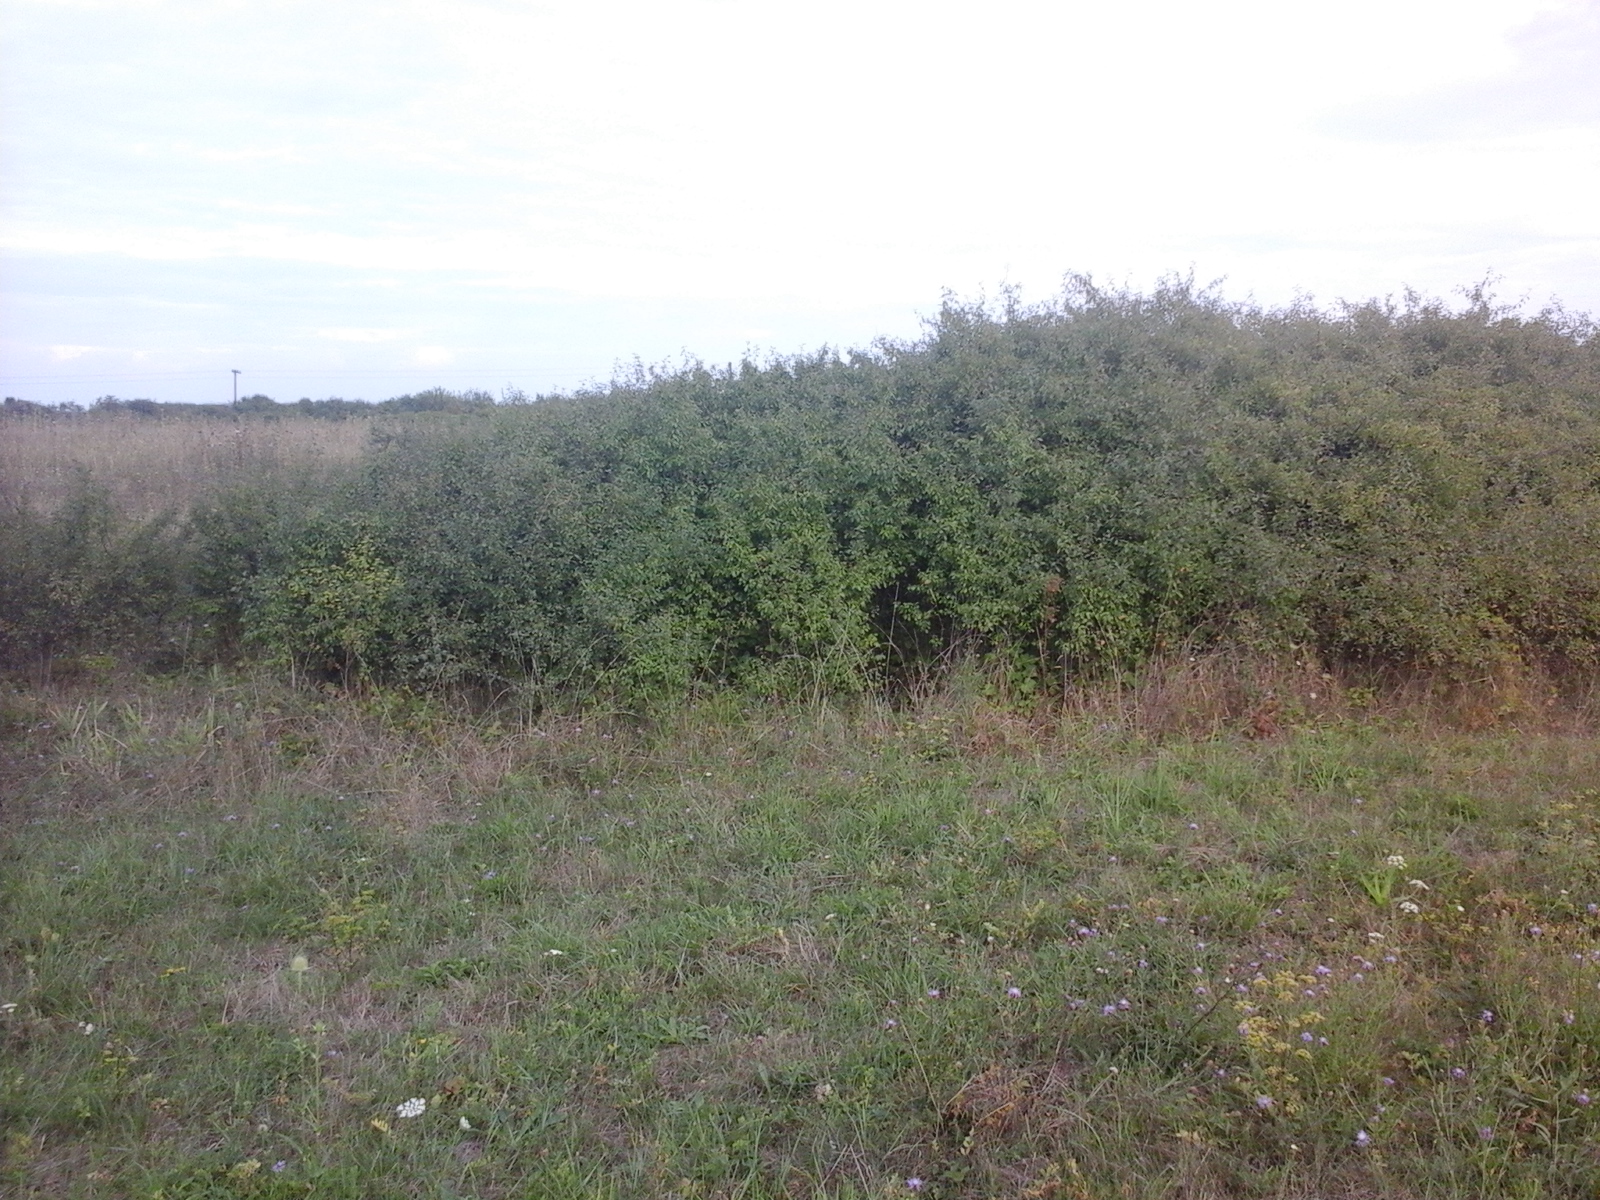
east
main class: Grassland
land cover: Grassland without tree/shrub cover
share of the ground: > 75 %
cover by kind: herbaceous plants 100 %
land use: Agriculture (excluding fallow land and kitchen gardens)
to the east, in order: Grassland without tree/shrub cover; Shrubland without tree cover; Ditches and canals; Grassland without tree/shrub cover; Tracks; Spontaneously vegetated surfaces; Shrubland with sparse tree cover; Railways; Shrubland without tree cover; Electric lines; Shrubland without tree cover; Ditches and canals; Grass margins; Tracks; Common wheat
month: August
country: RO
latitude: 46.7366
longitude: 21.5961
